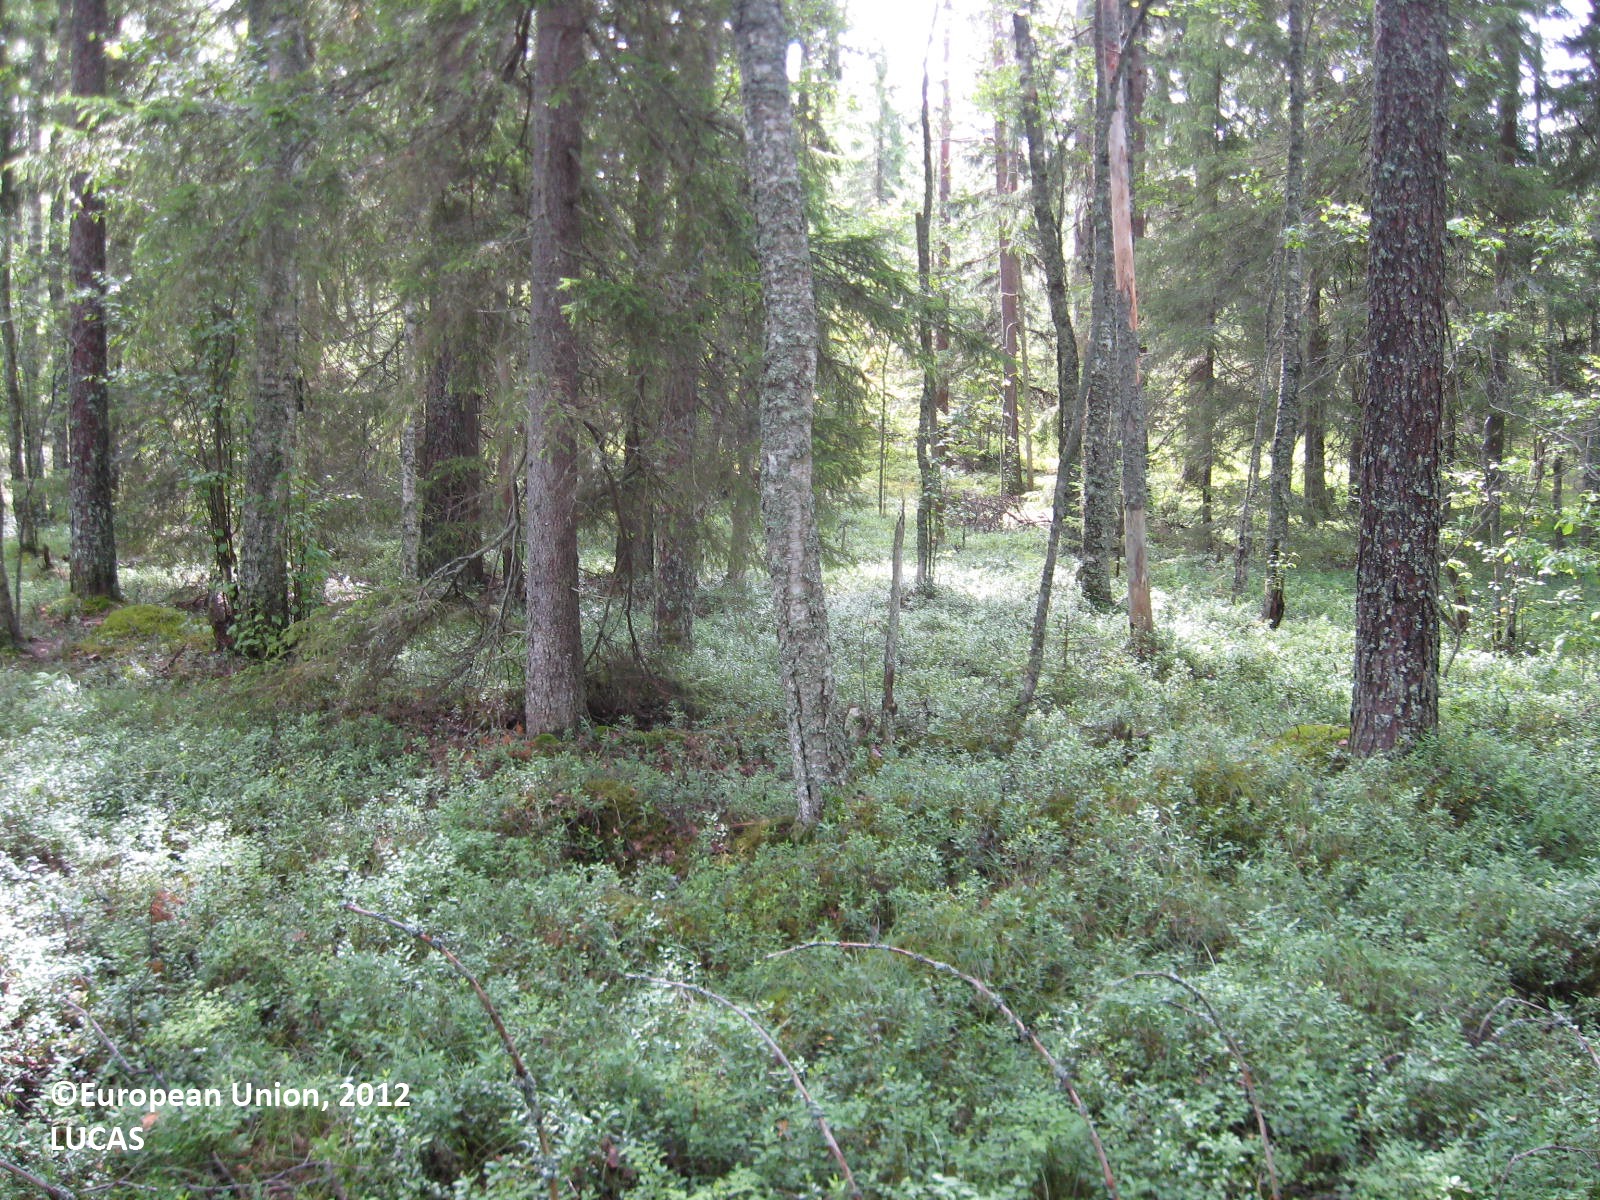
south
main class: Woodland
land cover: Other mixed woodland
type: boreal forest
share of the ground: > 75 %
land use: Forestry
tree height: > 5 m
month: July
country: FI
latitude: 62.0821
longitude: 22.7950
